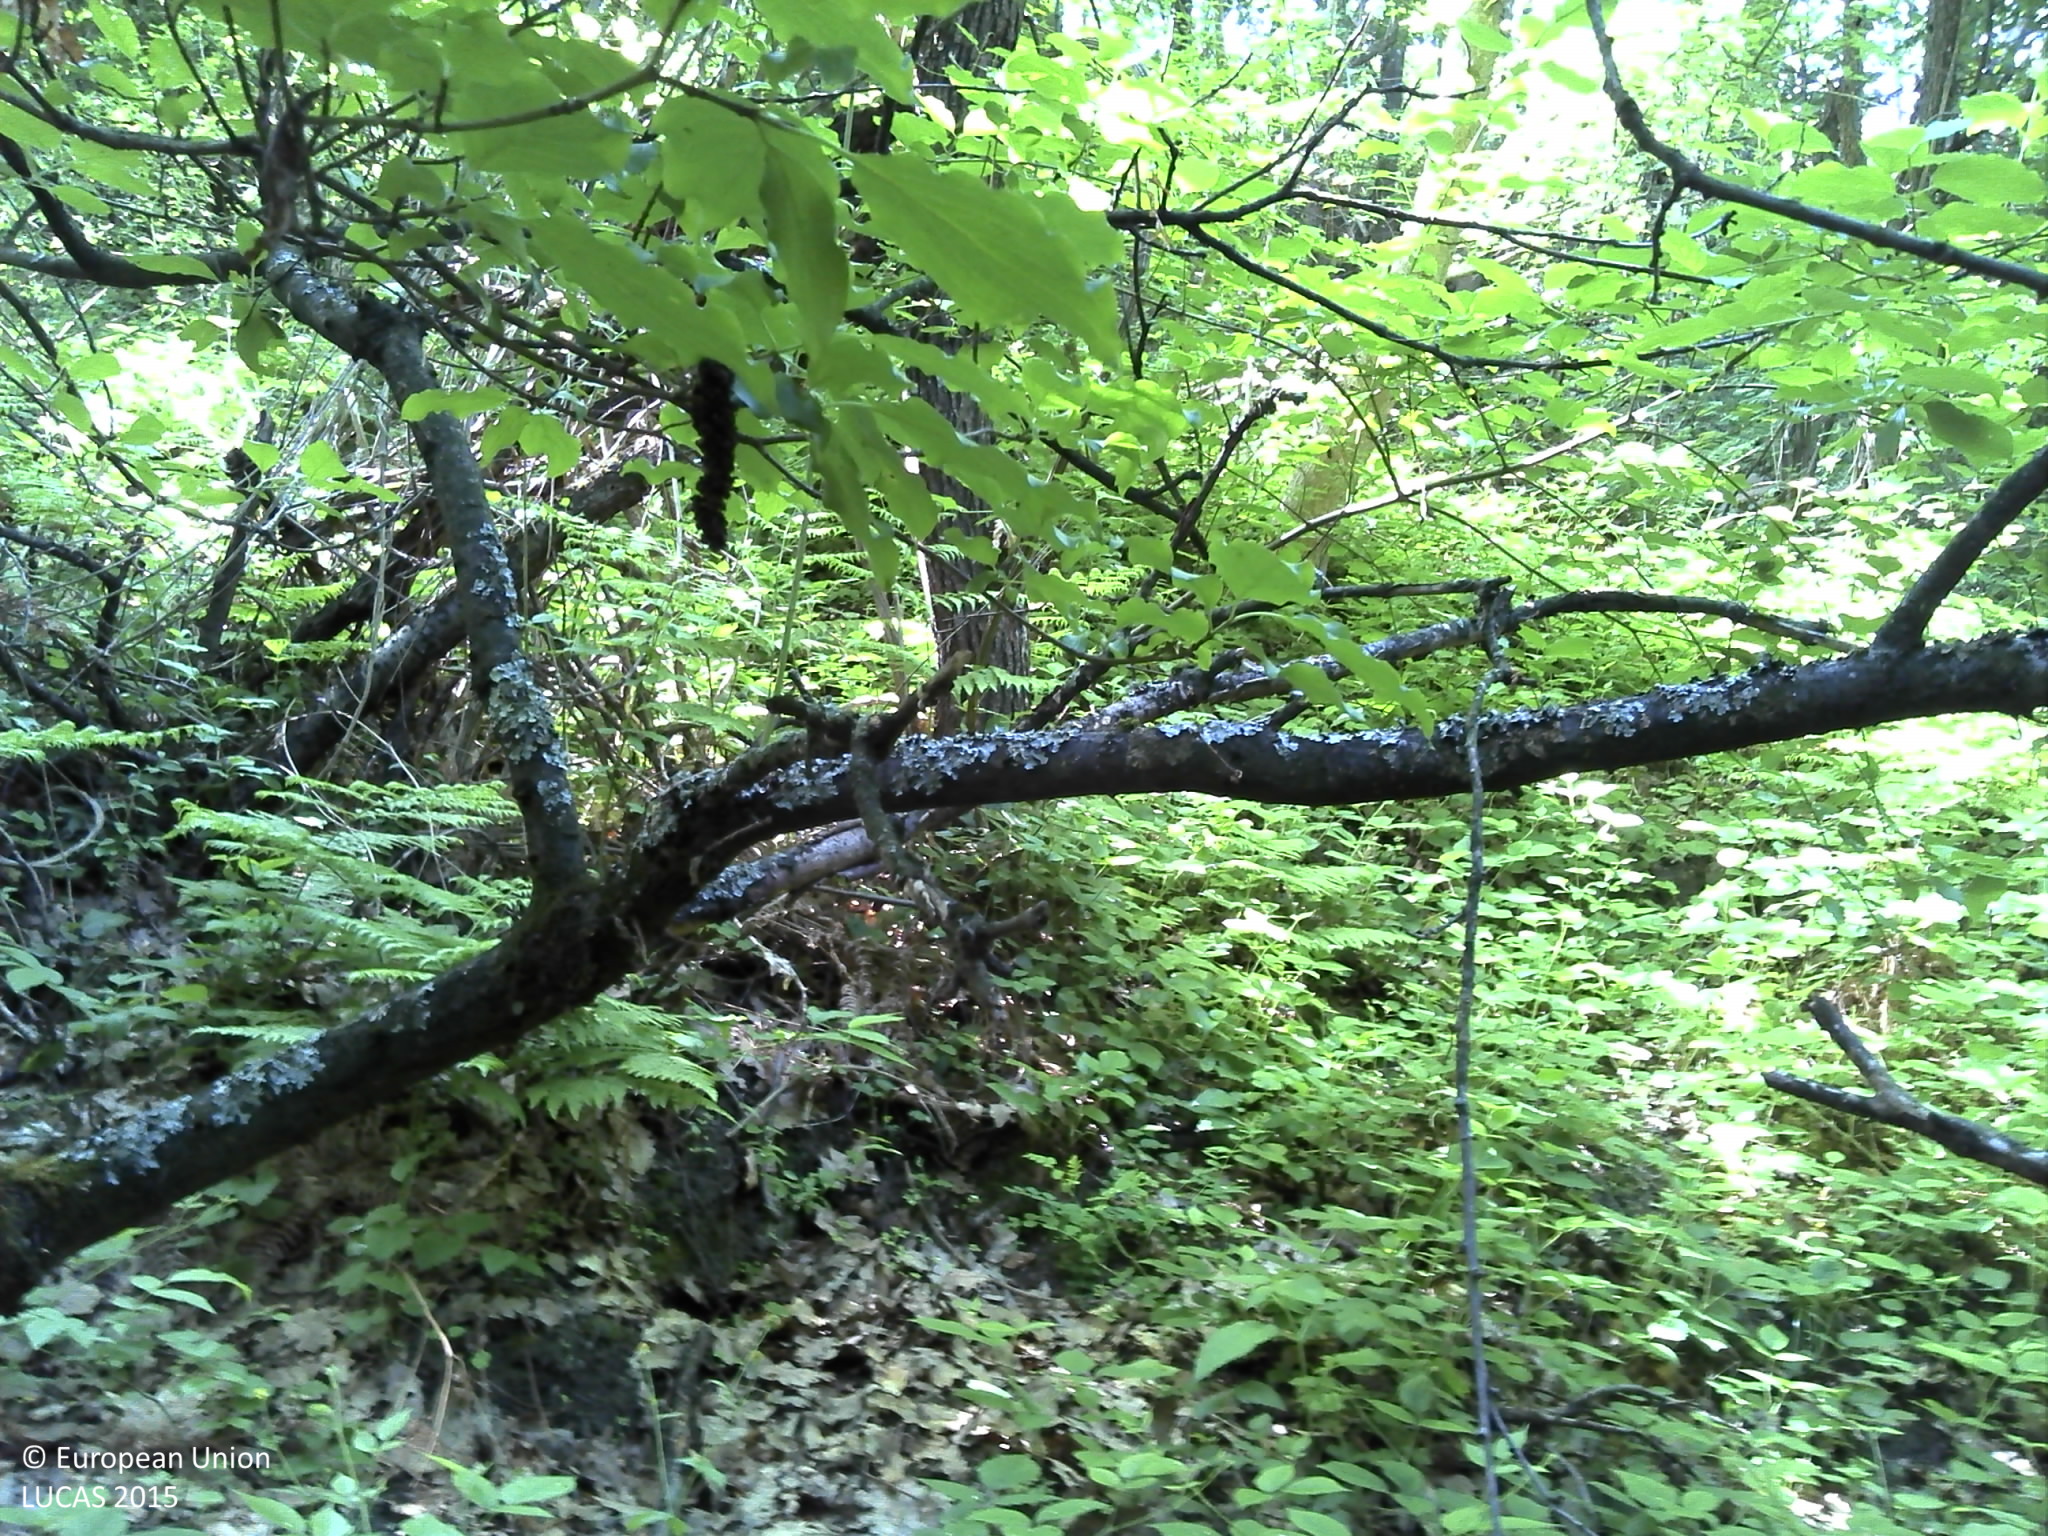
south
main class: Woodland
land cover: Broadleaved woodland
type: acidophilous oak and oak-birch forest
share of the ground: > 75 %
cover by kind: broadleaved forest trees 100 %
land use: Forestry
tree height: > 5 m
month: May
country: HR
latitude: 45.4344
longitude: 18.0184
